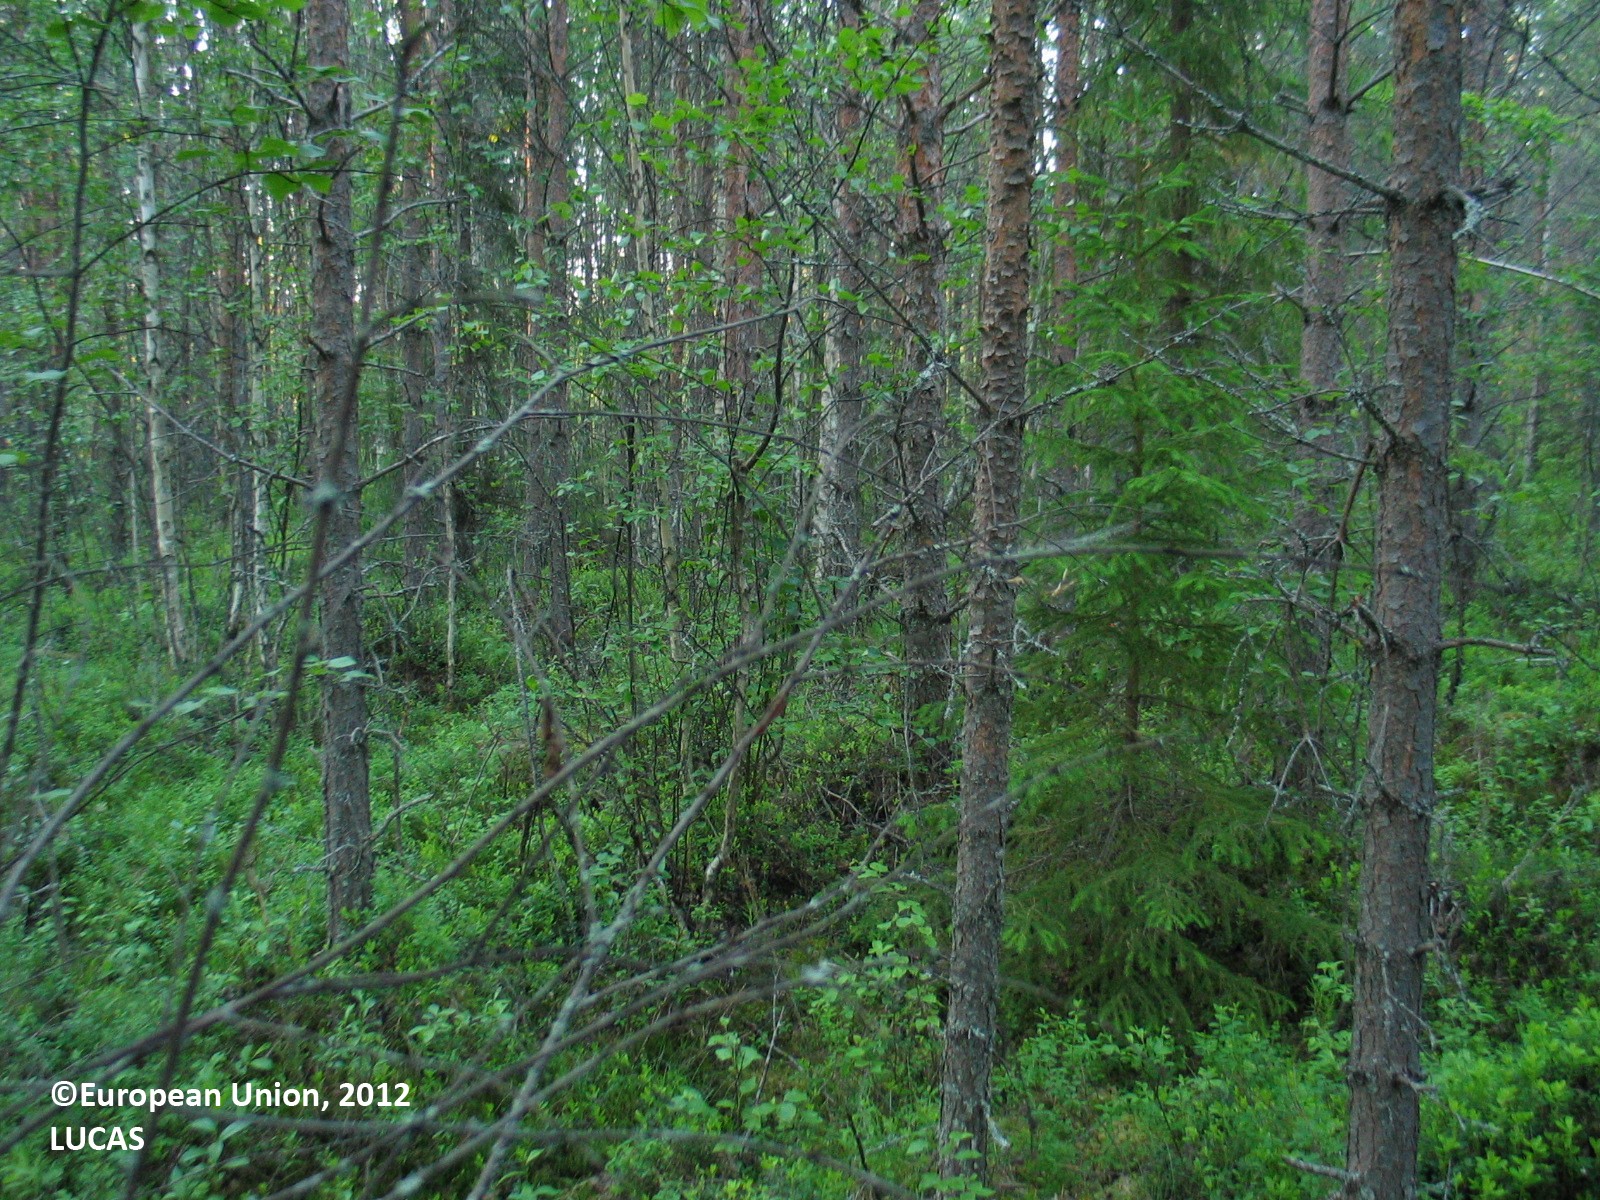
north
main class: Woodland
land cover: Pine dominated mixed woodland
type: boreal forest
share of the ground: > 75 %
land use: Forestry
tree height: > 5 m
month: July
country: FI
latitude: 64.7912
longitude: 26.6328
